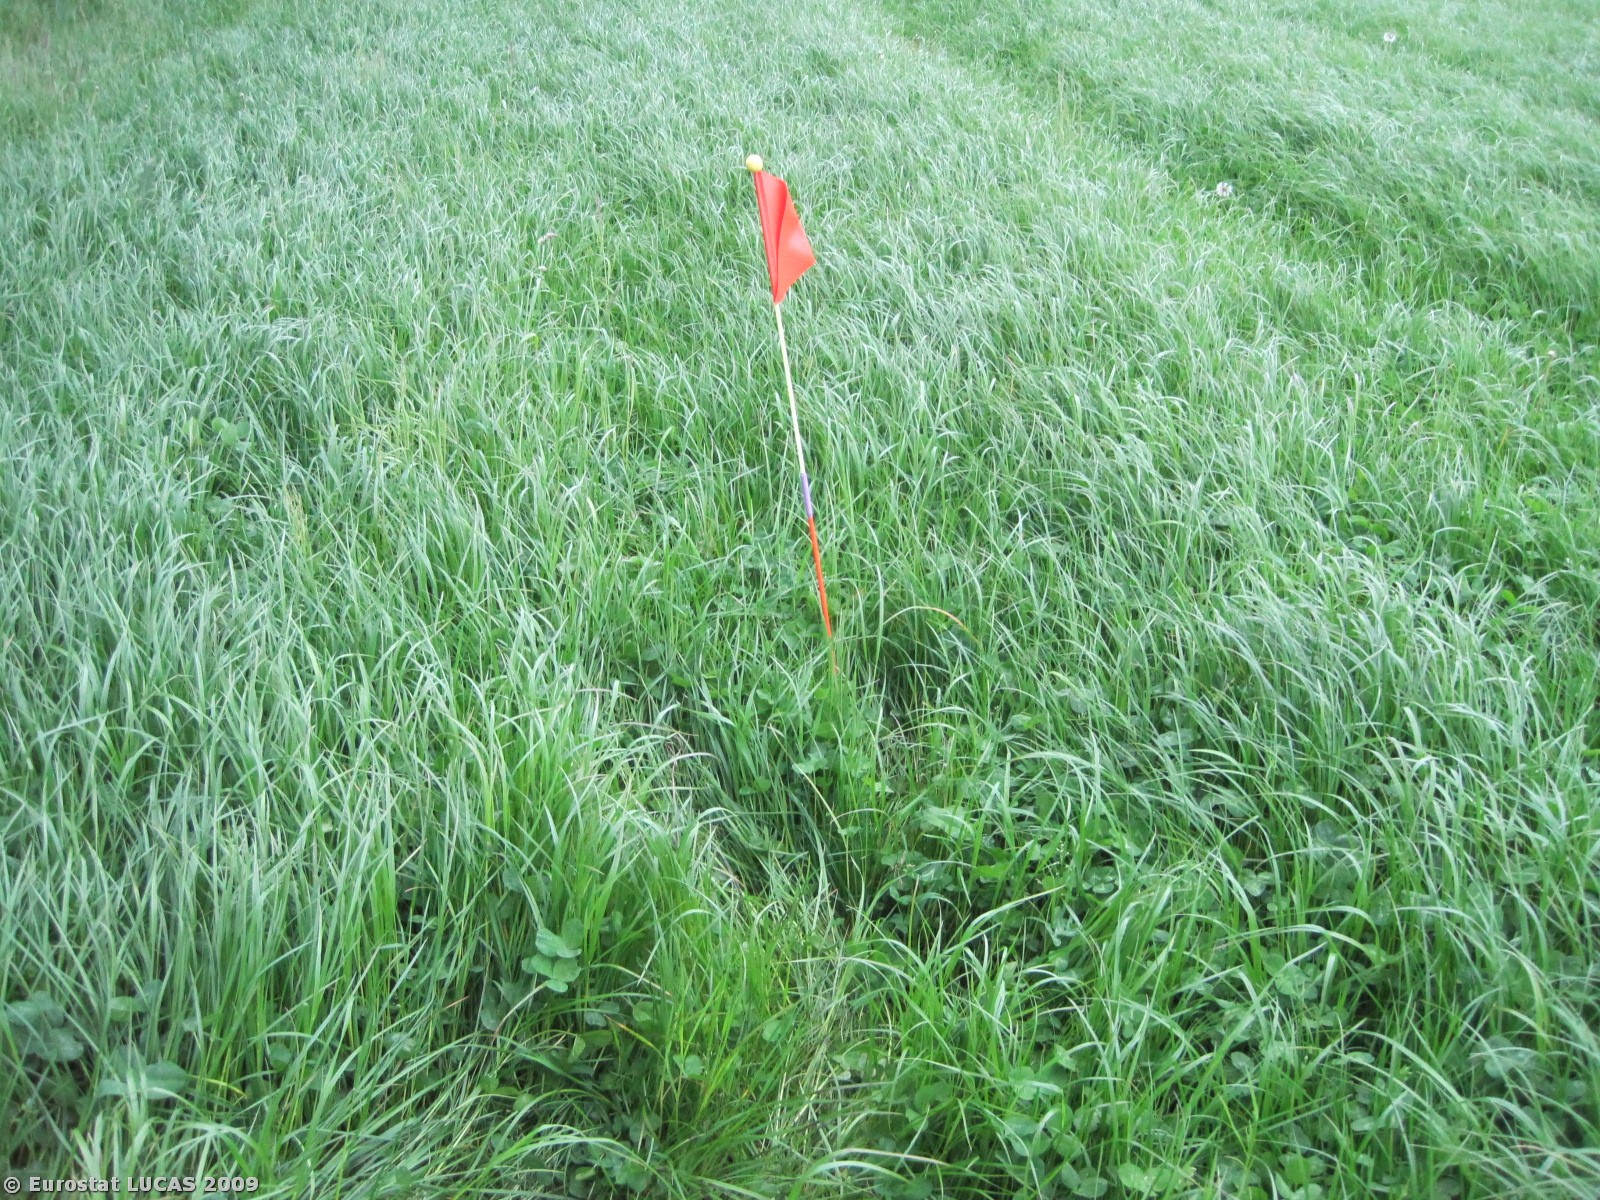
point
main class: Grassland
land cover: Grassland without tree/shrub cover
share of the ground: > 75 %
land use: Agriculture (excluding fallow land and kitchen gardens)
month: May
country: DK
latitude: 56.8347
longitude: 9.7545
